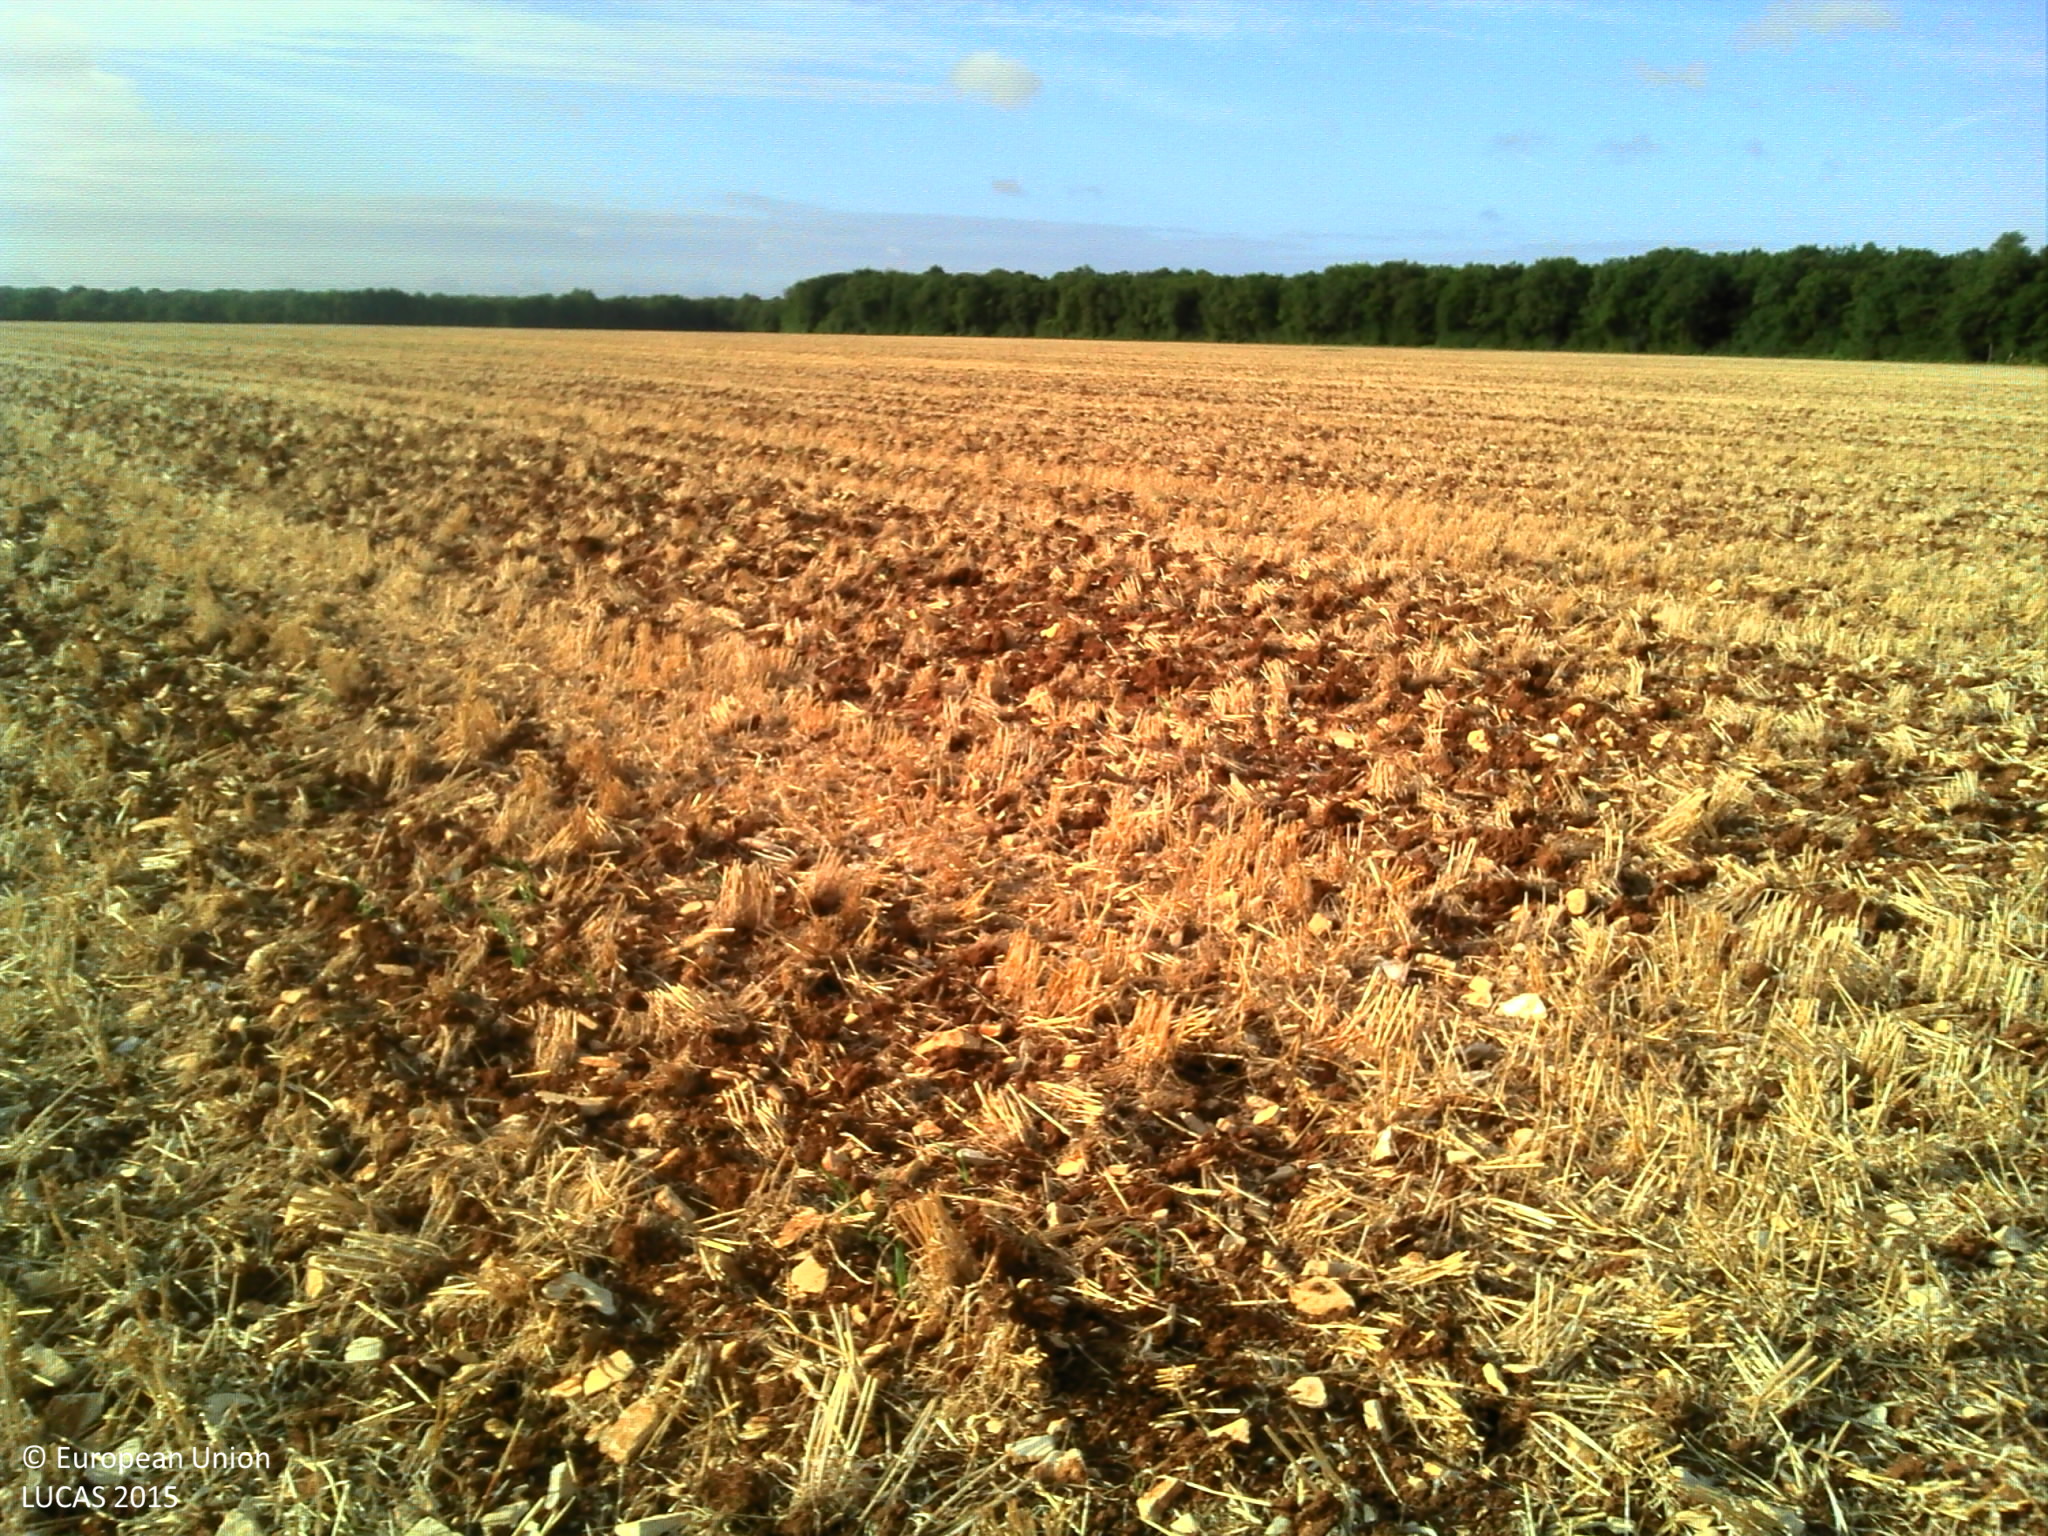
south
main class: Cropland
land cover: Barley
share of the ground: > 75 %
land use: Agriculture (excluding fallow land and kitchen gardens)
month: July
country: FR
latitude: 46.9205
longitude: 2.2579
